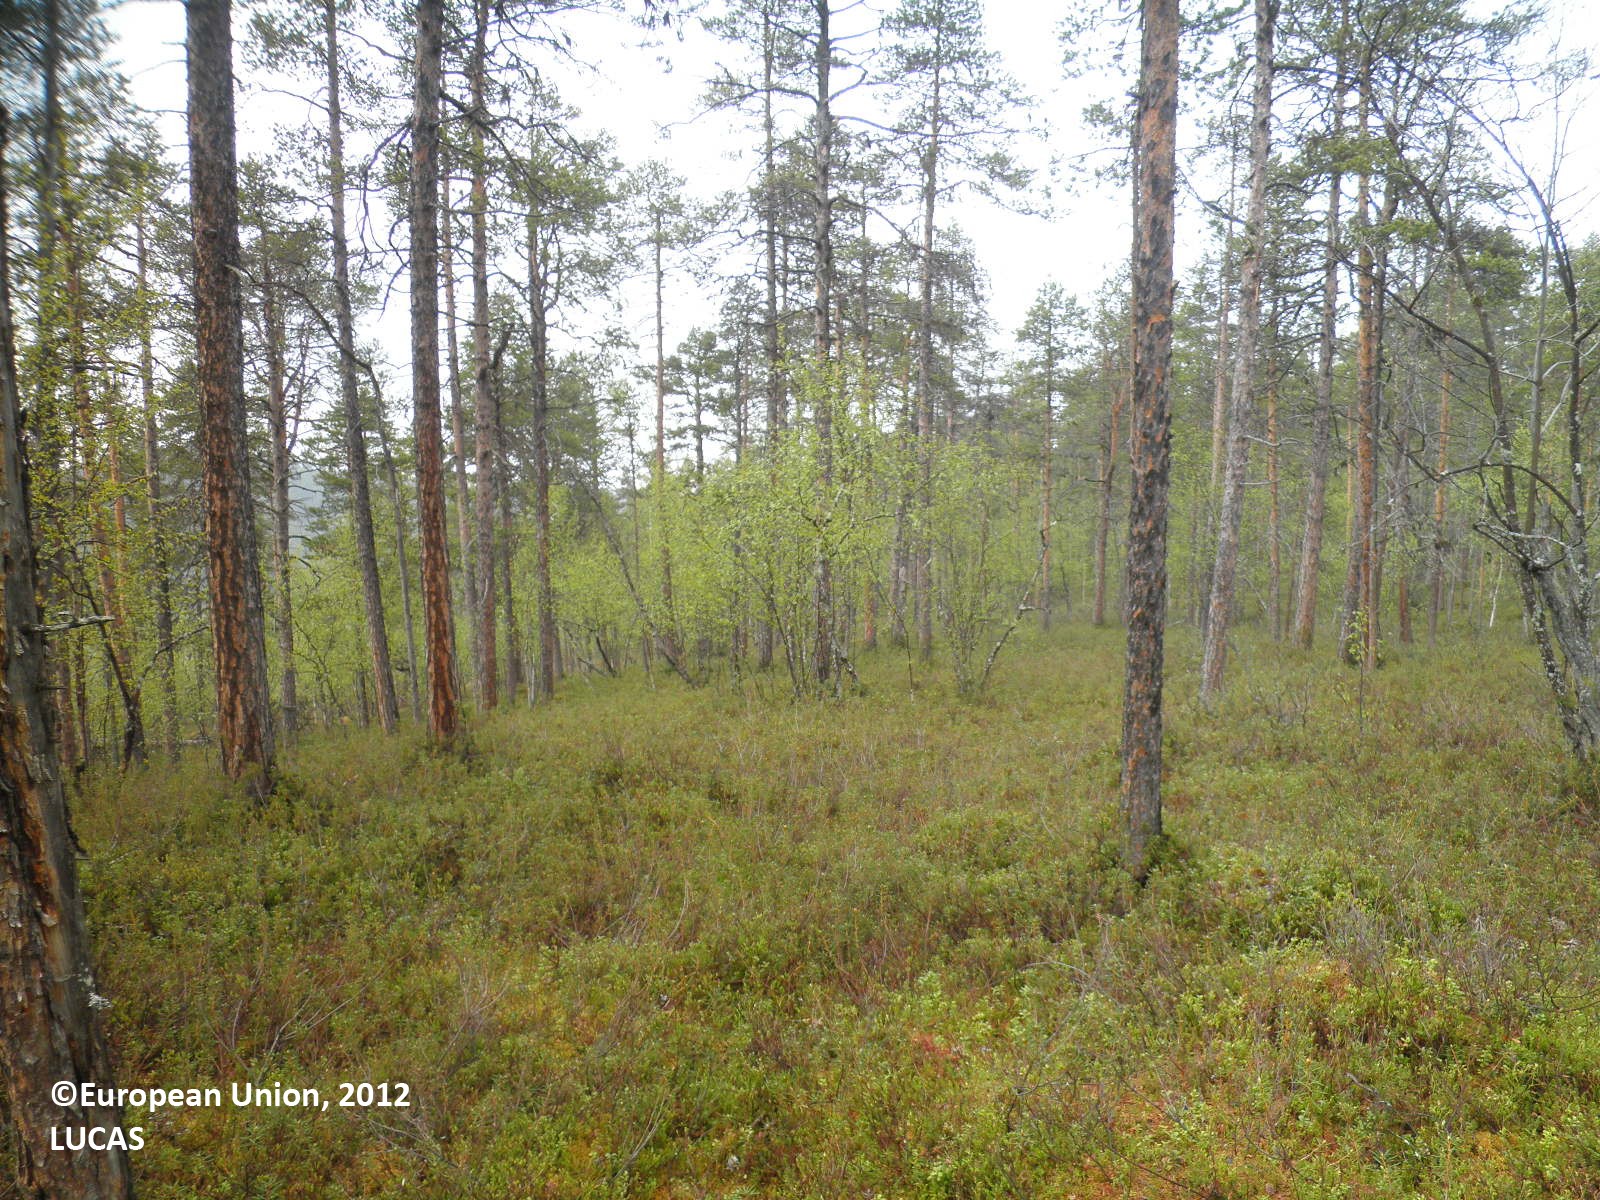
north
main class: Woodland
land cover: Pine dominated mixed woodland
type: boreal forest
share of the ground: > 75 %
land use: Forestry
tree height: > 5 m
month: June
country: FI
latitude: 69.0069
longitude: 26.9901
